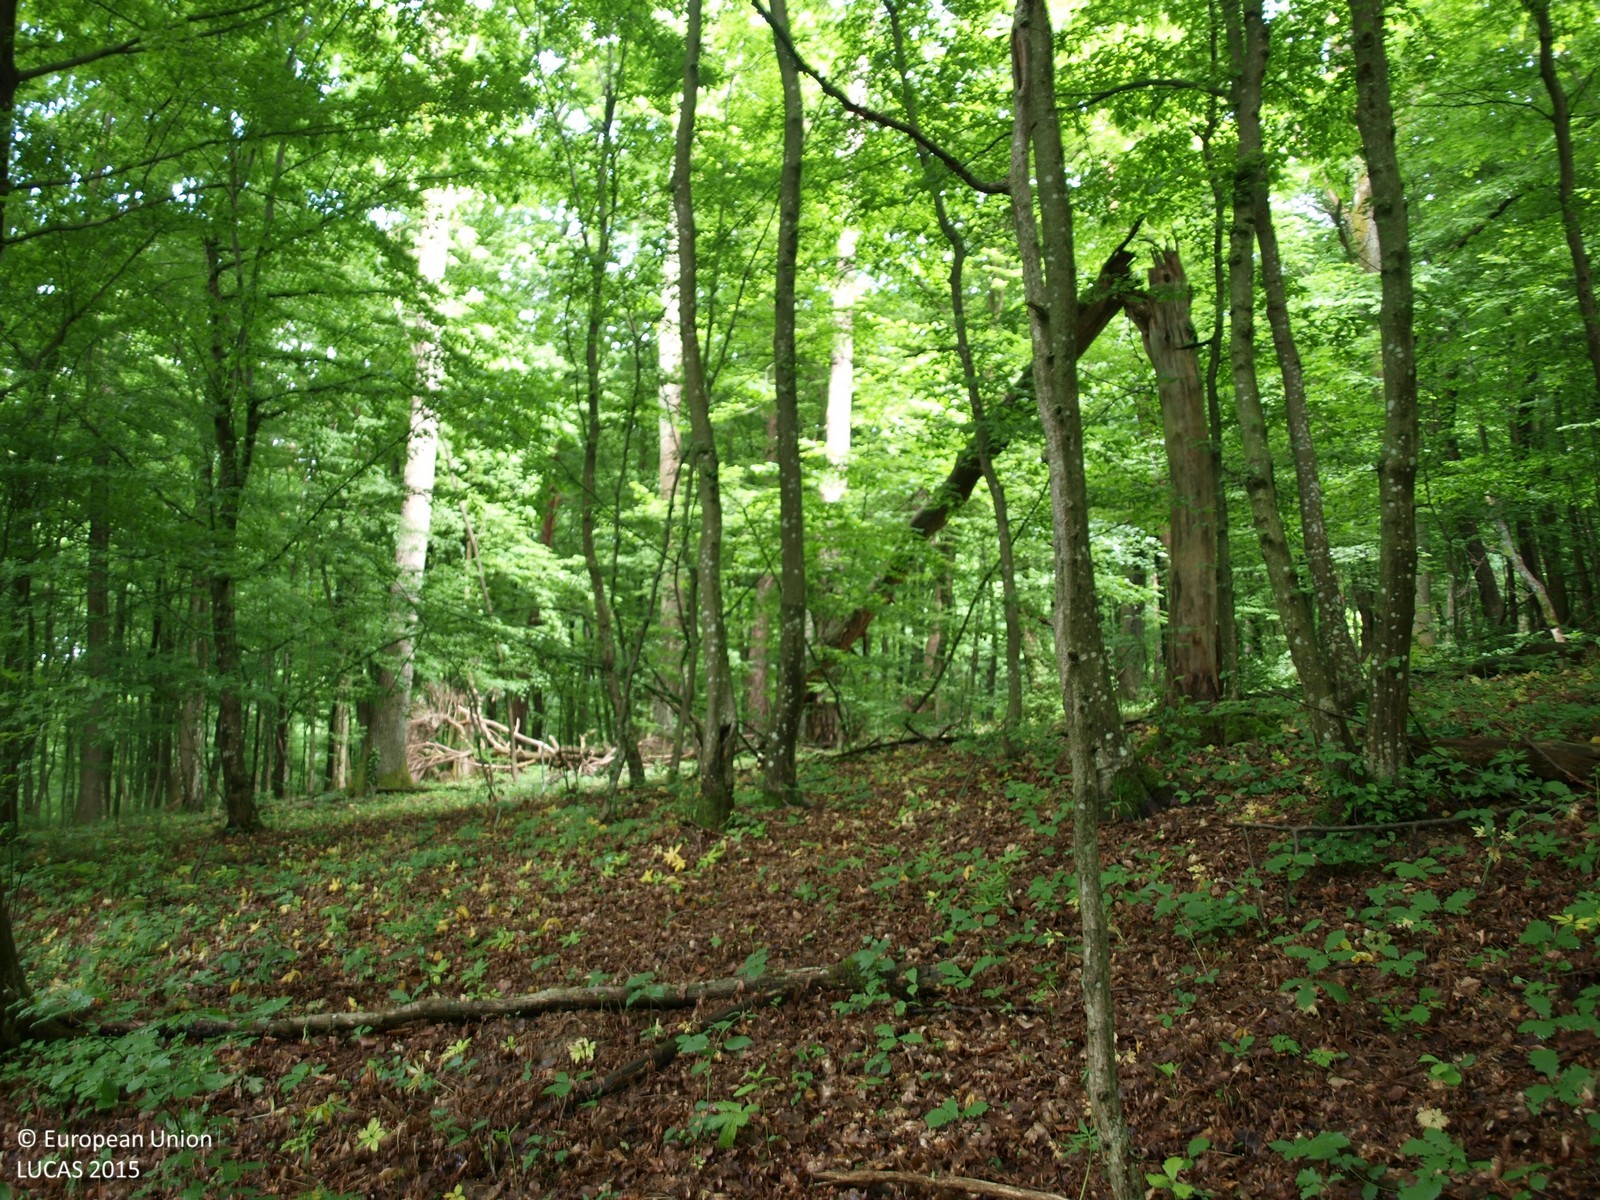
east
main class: Woodland
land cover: Broadleaved woodland
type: mesophytic deciduous forest
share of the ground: > 75 %
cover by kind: broadleaved forest trees 95 %, shrubs 5 %
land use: Forestry
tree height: > 5 m
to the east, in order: Broadleaved woodland; Tracks; Broadleaved woodland
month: May
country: HR
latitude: 46.1352
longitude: 16.1995
